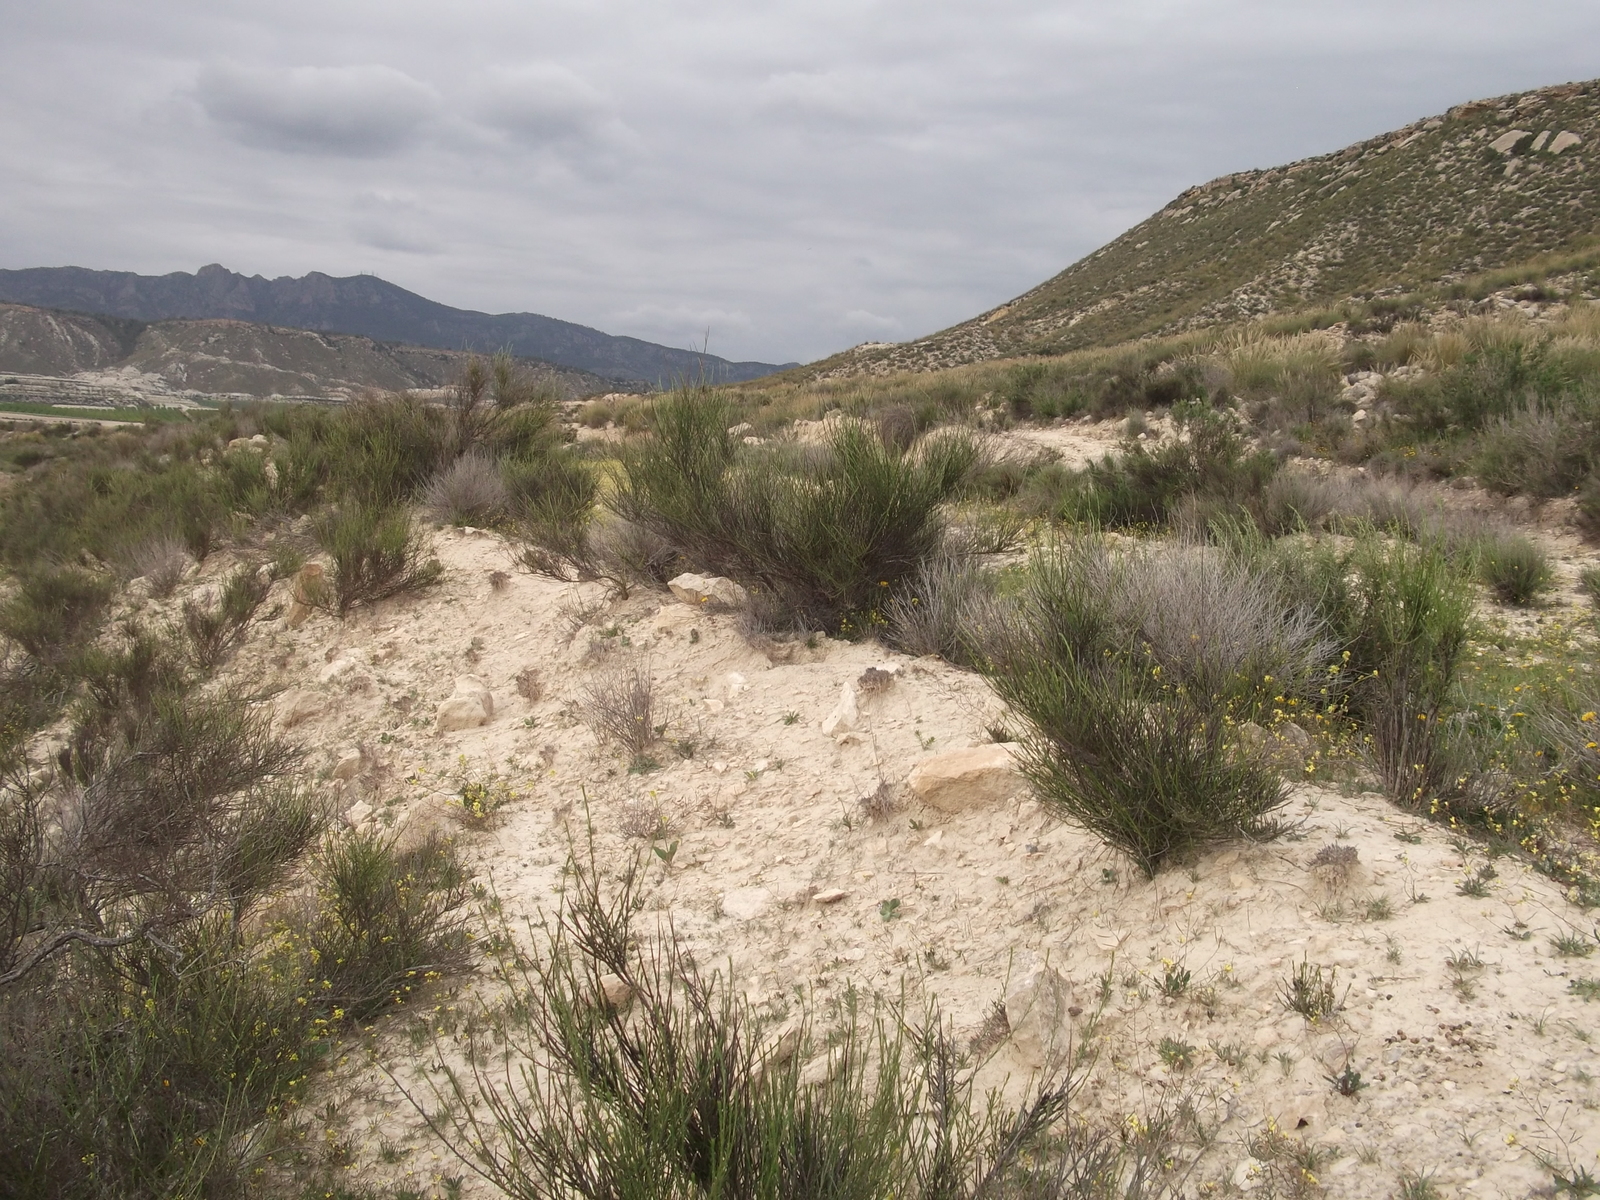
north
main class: Shrubland
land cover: Shrubland without tree cover
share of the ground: 10 - 25 %
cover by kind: consolidated bare surface 80 %, shrubs 20 %
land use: Semi-natural and natural areas not in use
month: April
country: ES
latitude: 38.0663
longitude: -1.3957
